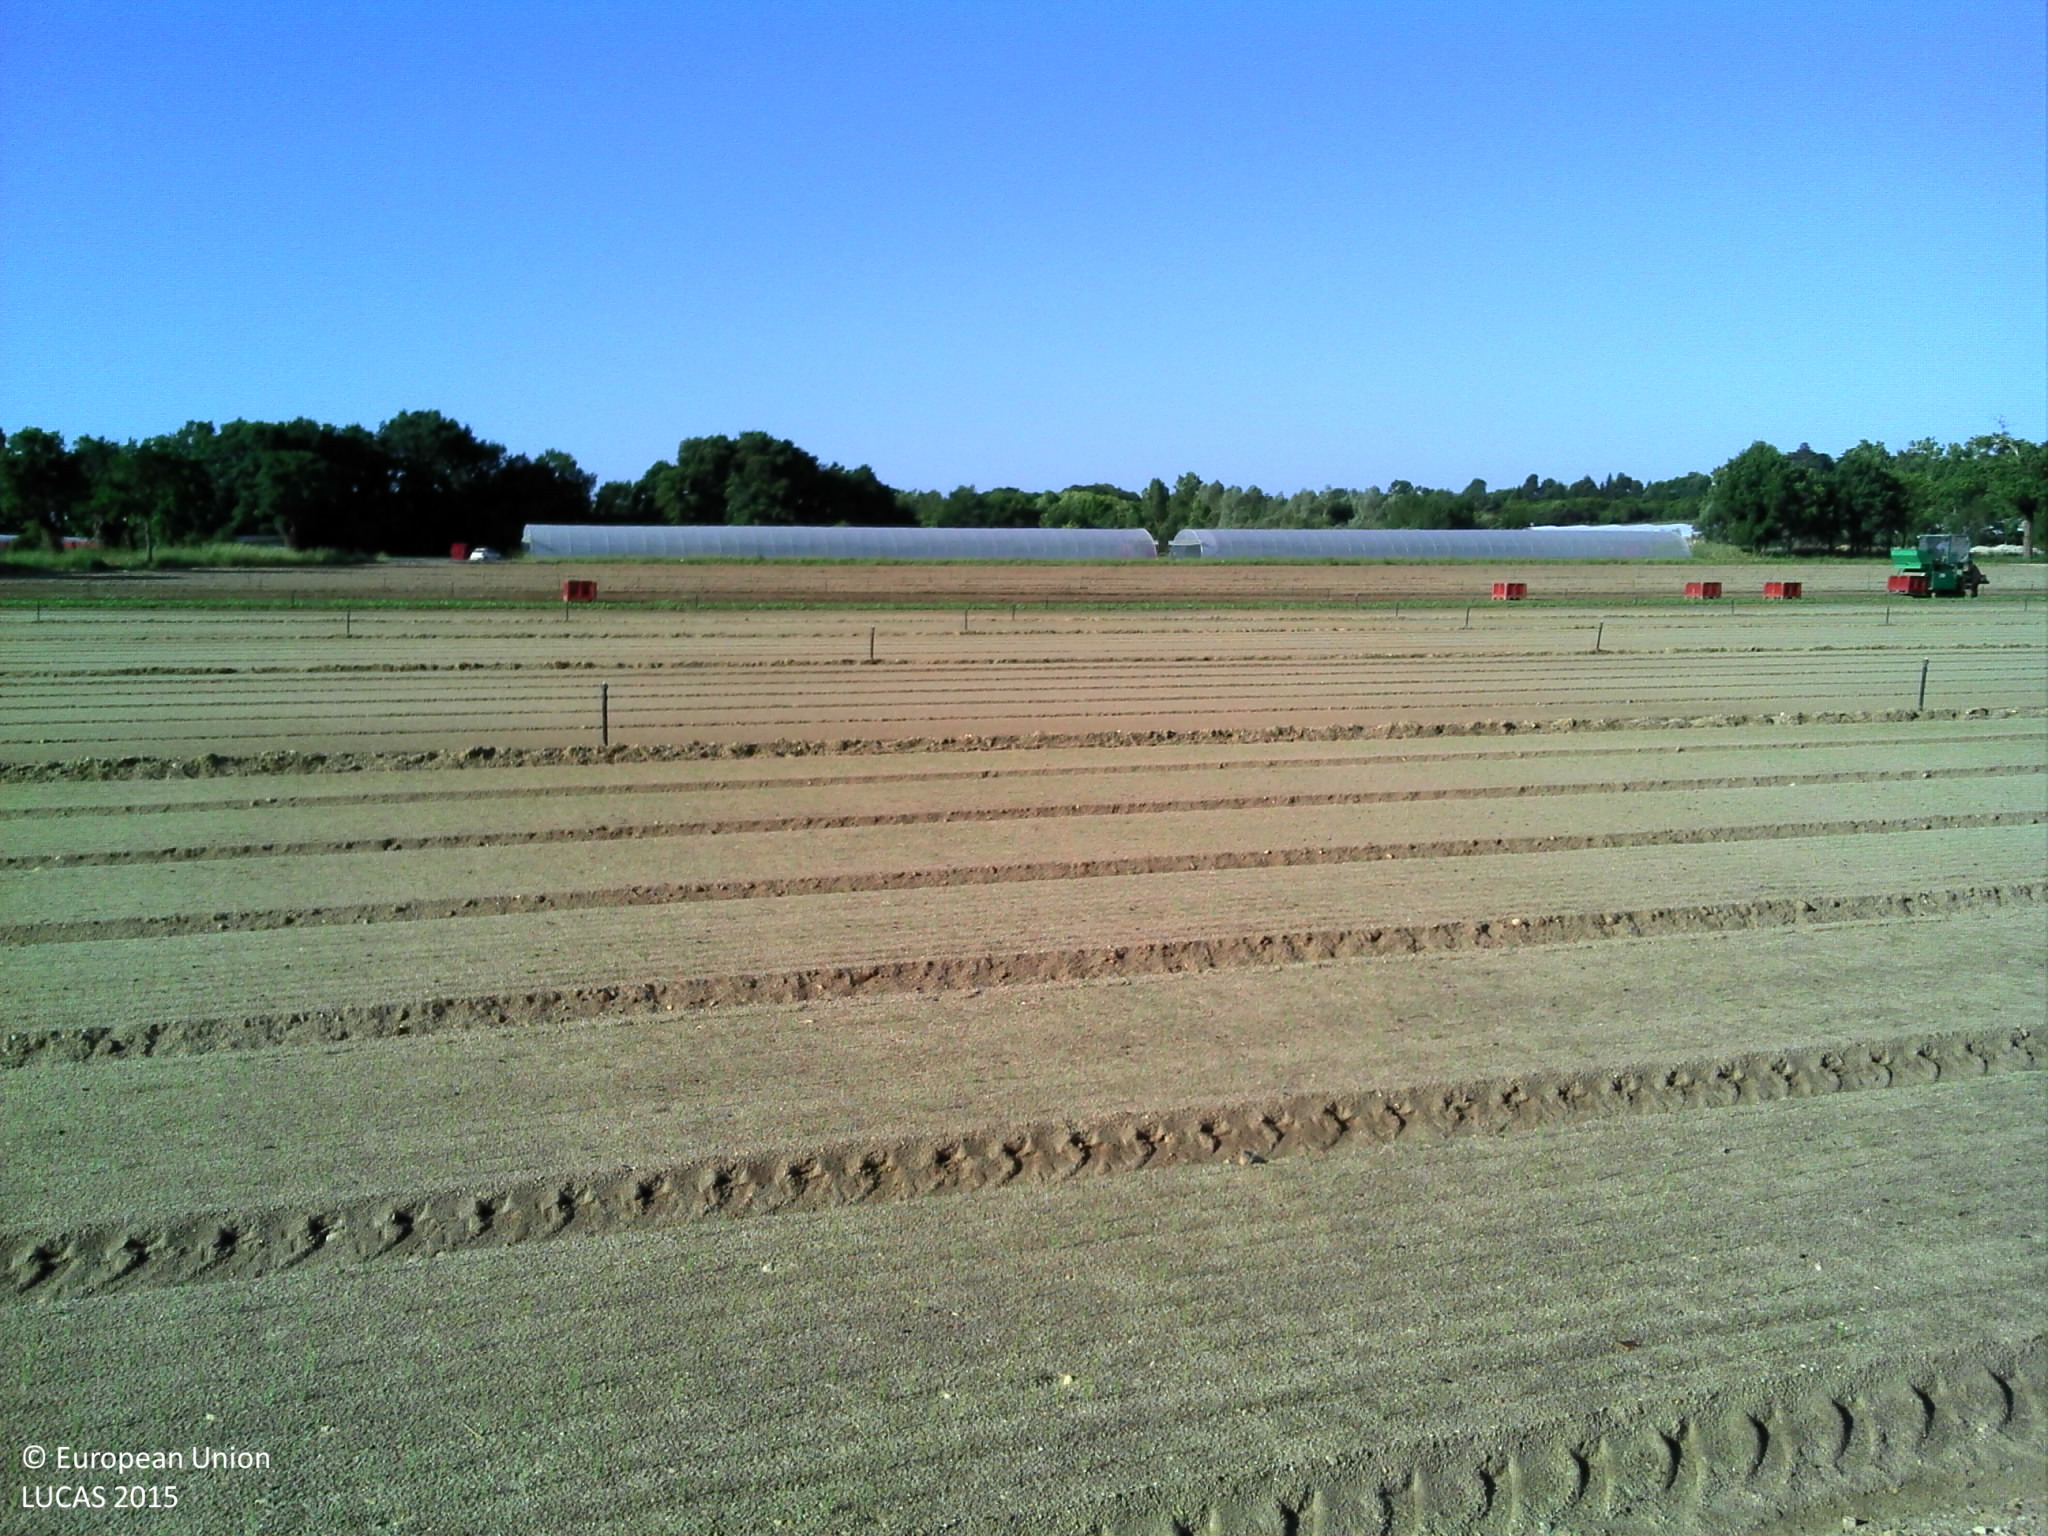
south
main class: Cropland
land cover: Other fresh vegetables
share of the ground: < 10 %
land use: Agriculture (excluding fallow land and kitchen gardens)
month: June
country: FR
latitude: 47.2972
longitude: -1.4540
